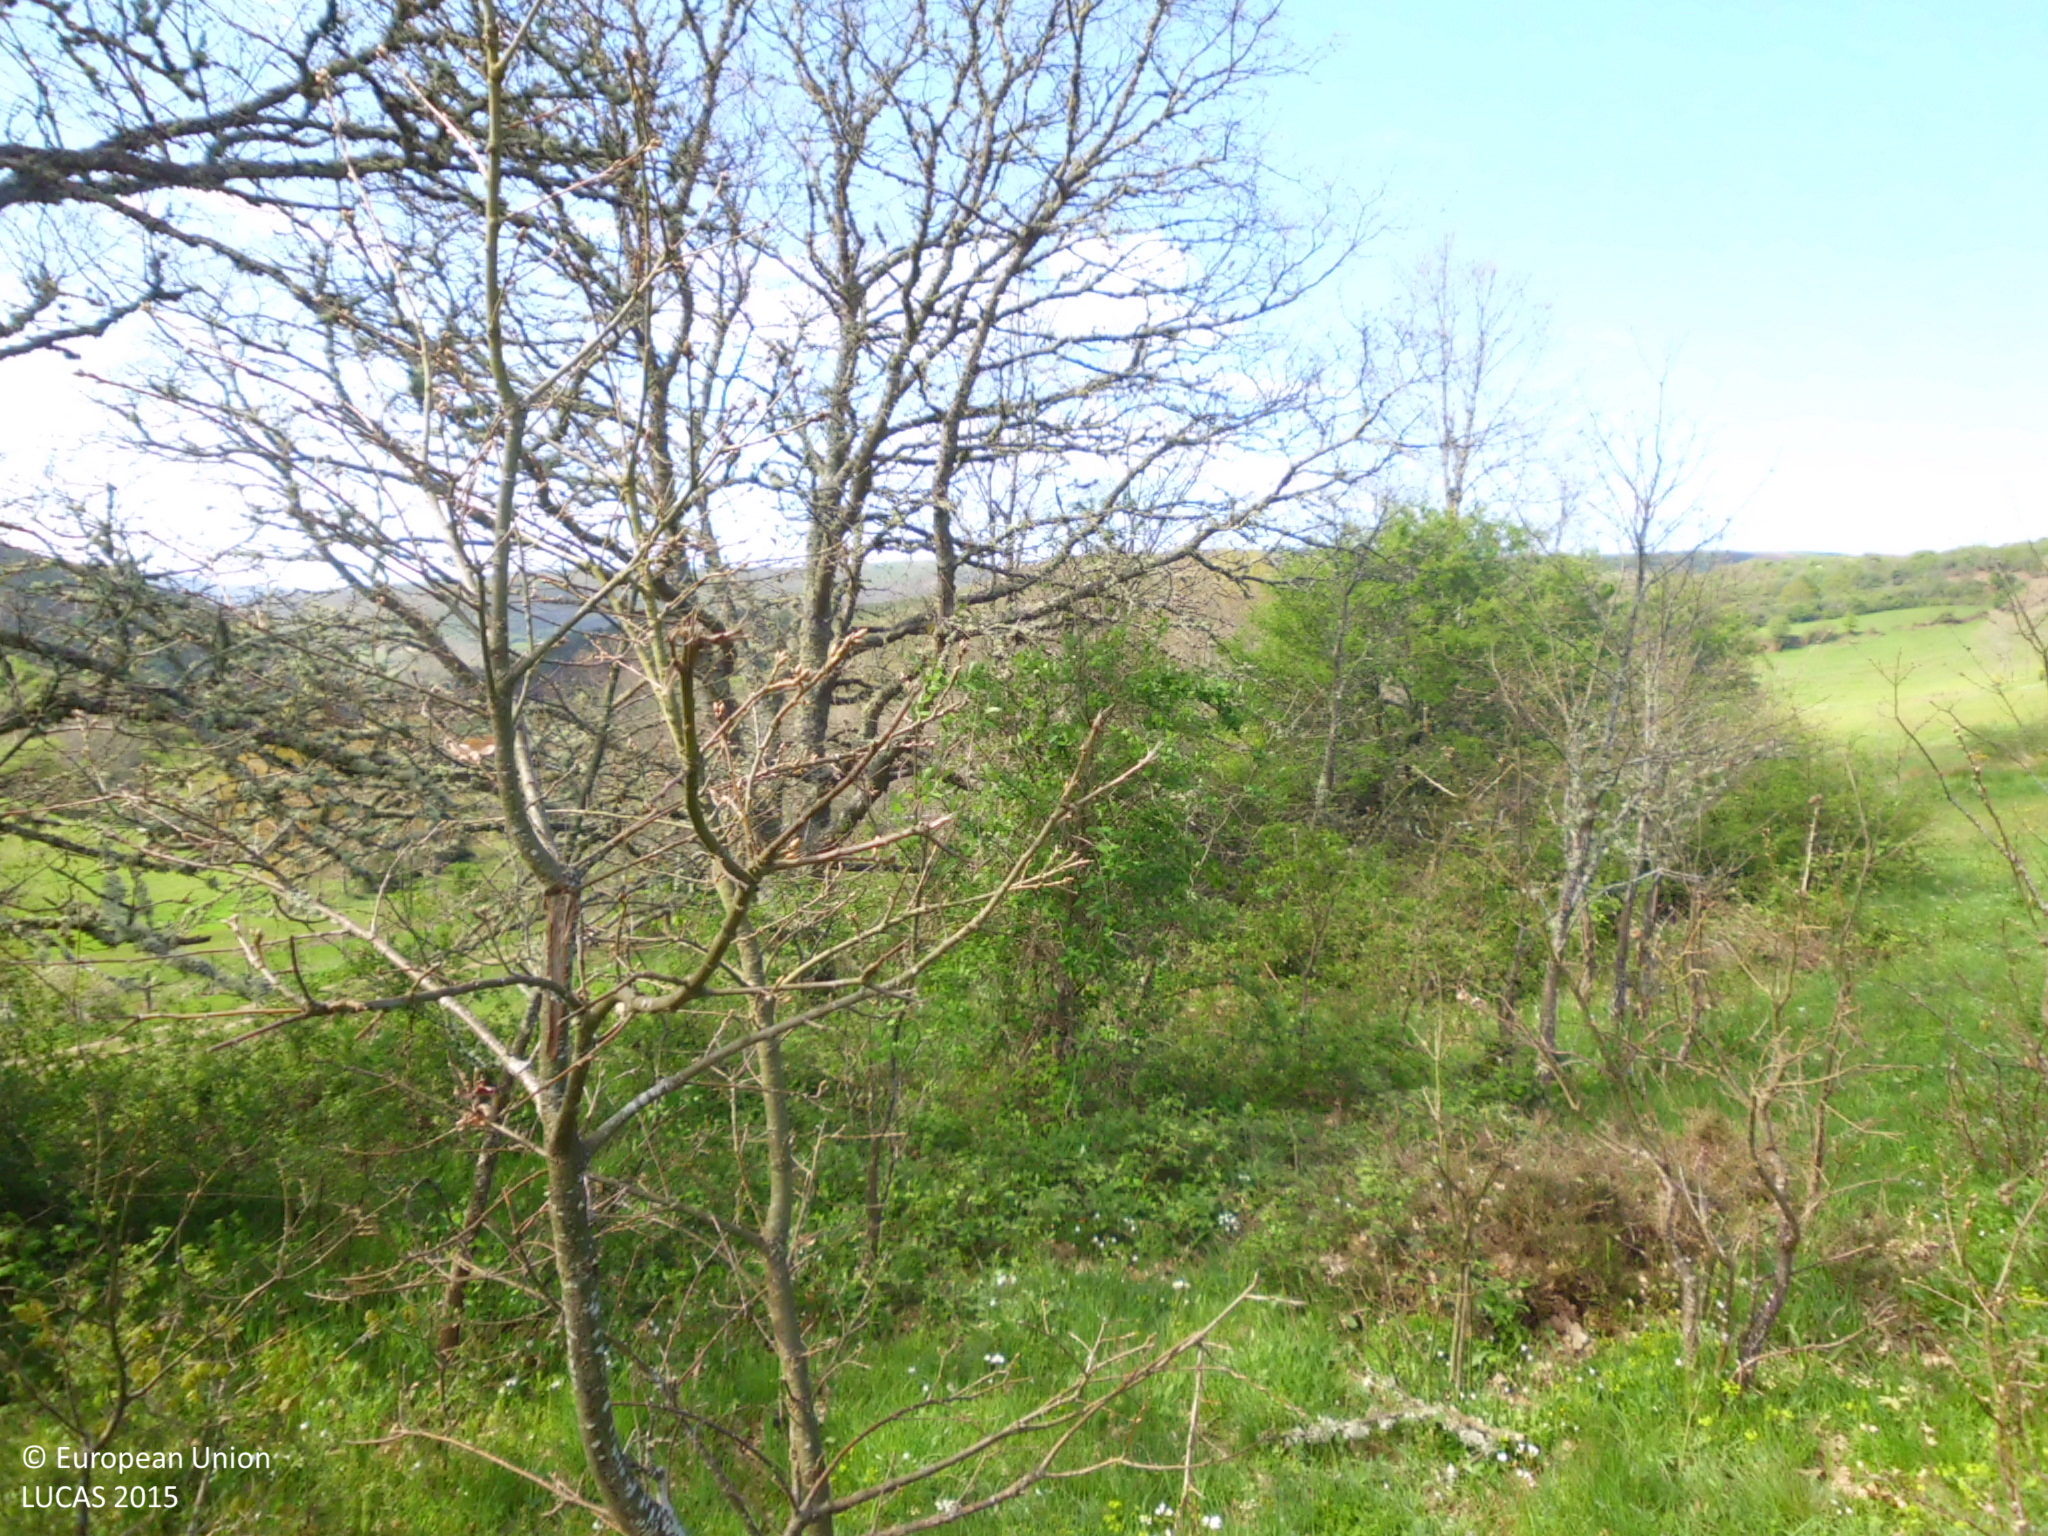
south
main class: Grassland
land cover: Grassland with sparse tree/shrub cover
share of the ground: 25 - 50 %
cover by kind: herbaceous plants 90 %, broadleaved forest trees 5 %, shrubs 5 %
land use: Abandoned areas
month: May
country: ES
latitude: 42.8950
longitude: -3.9201
